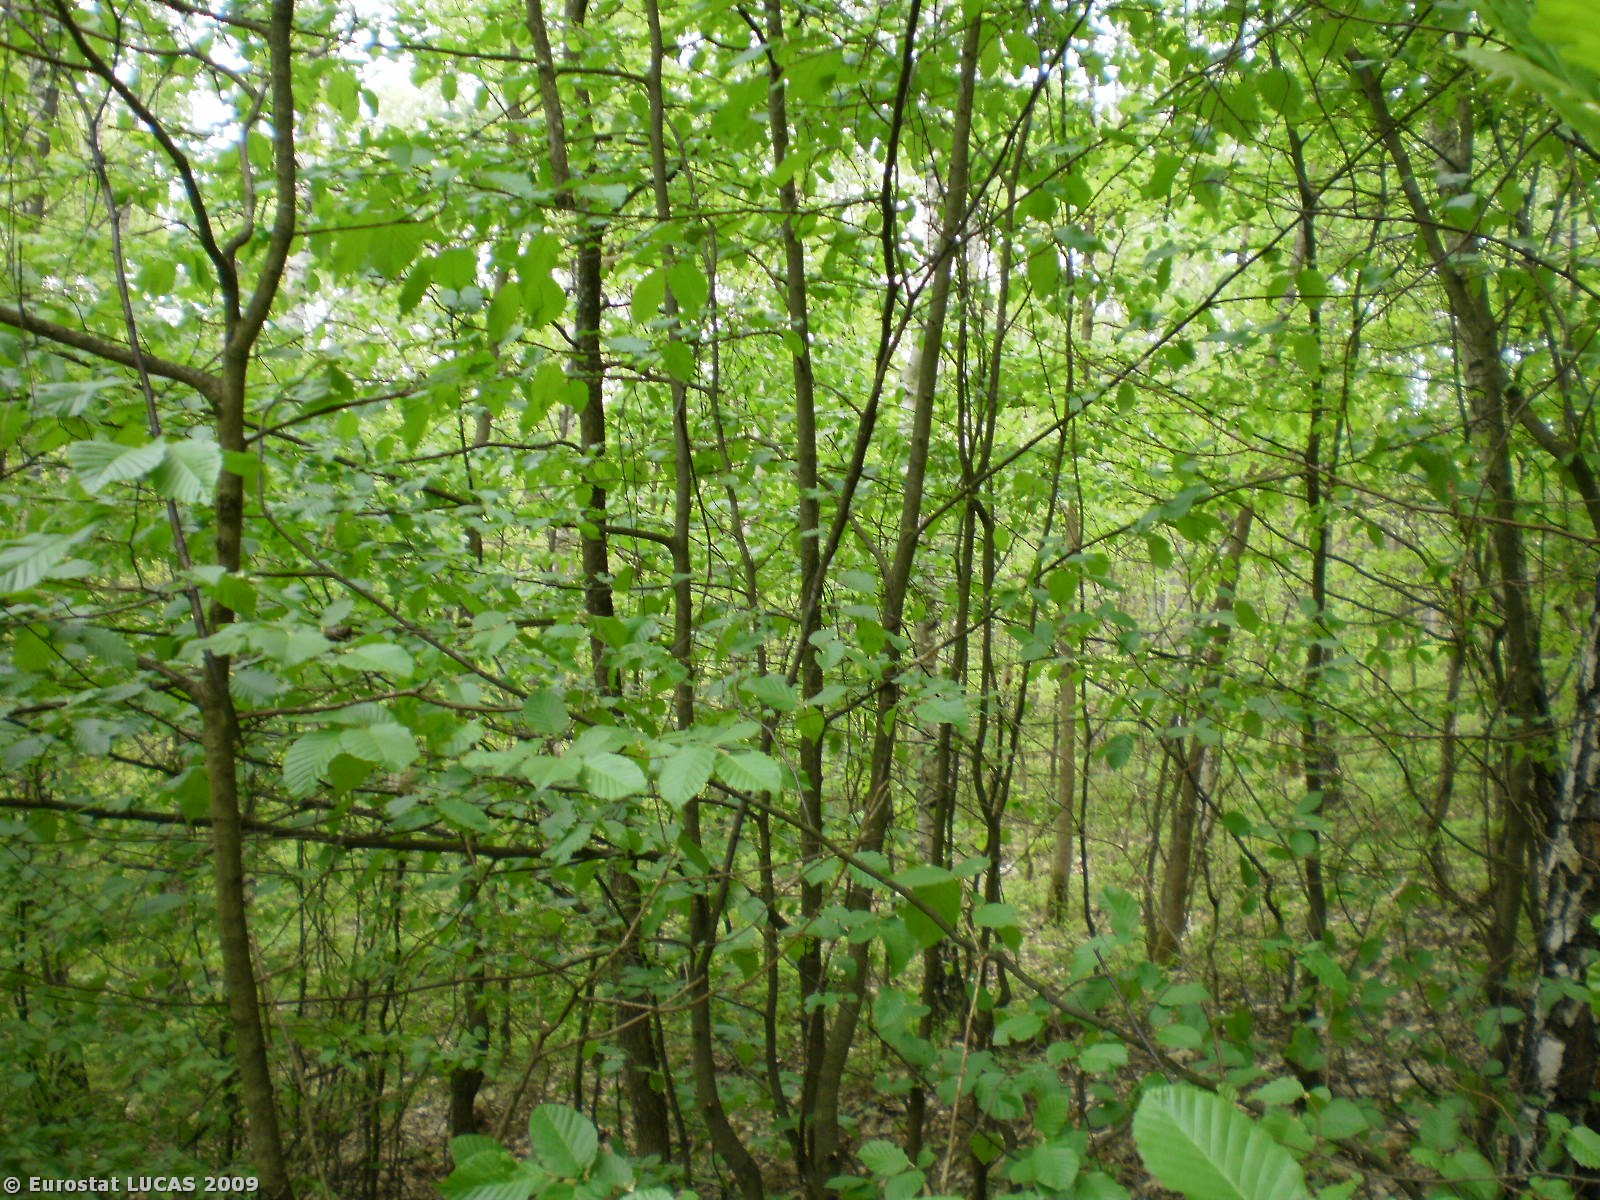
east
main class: Woodland
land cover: Broadleaved woodland
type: mesophytic deciduous forest
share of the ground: > 75 %
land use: Forestry
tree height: > 5 m
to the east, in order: Broadleaved woodland; Mixed woodland; Tracks; Coniferous woodland
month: May
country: PL
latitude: 53.6190
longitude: 18.8649
